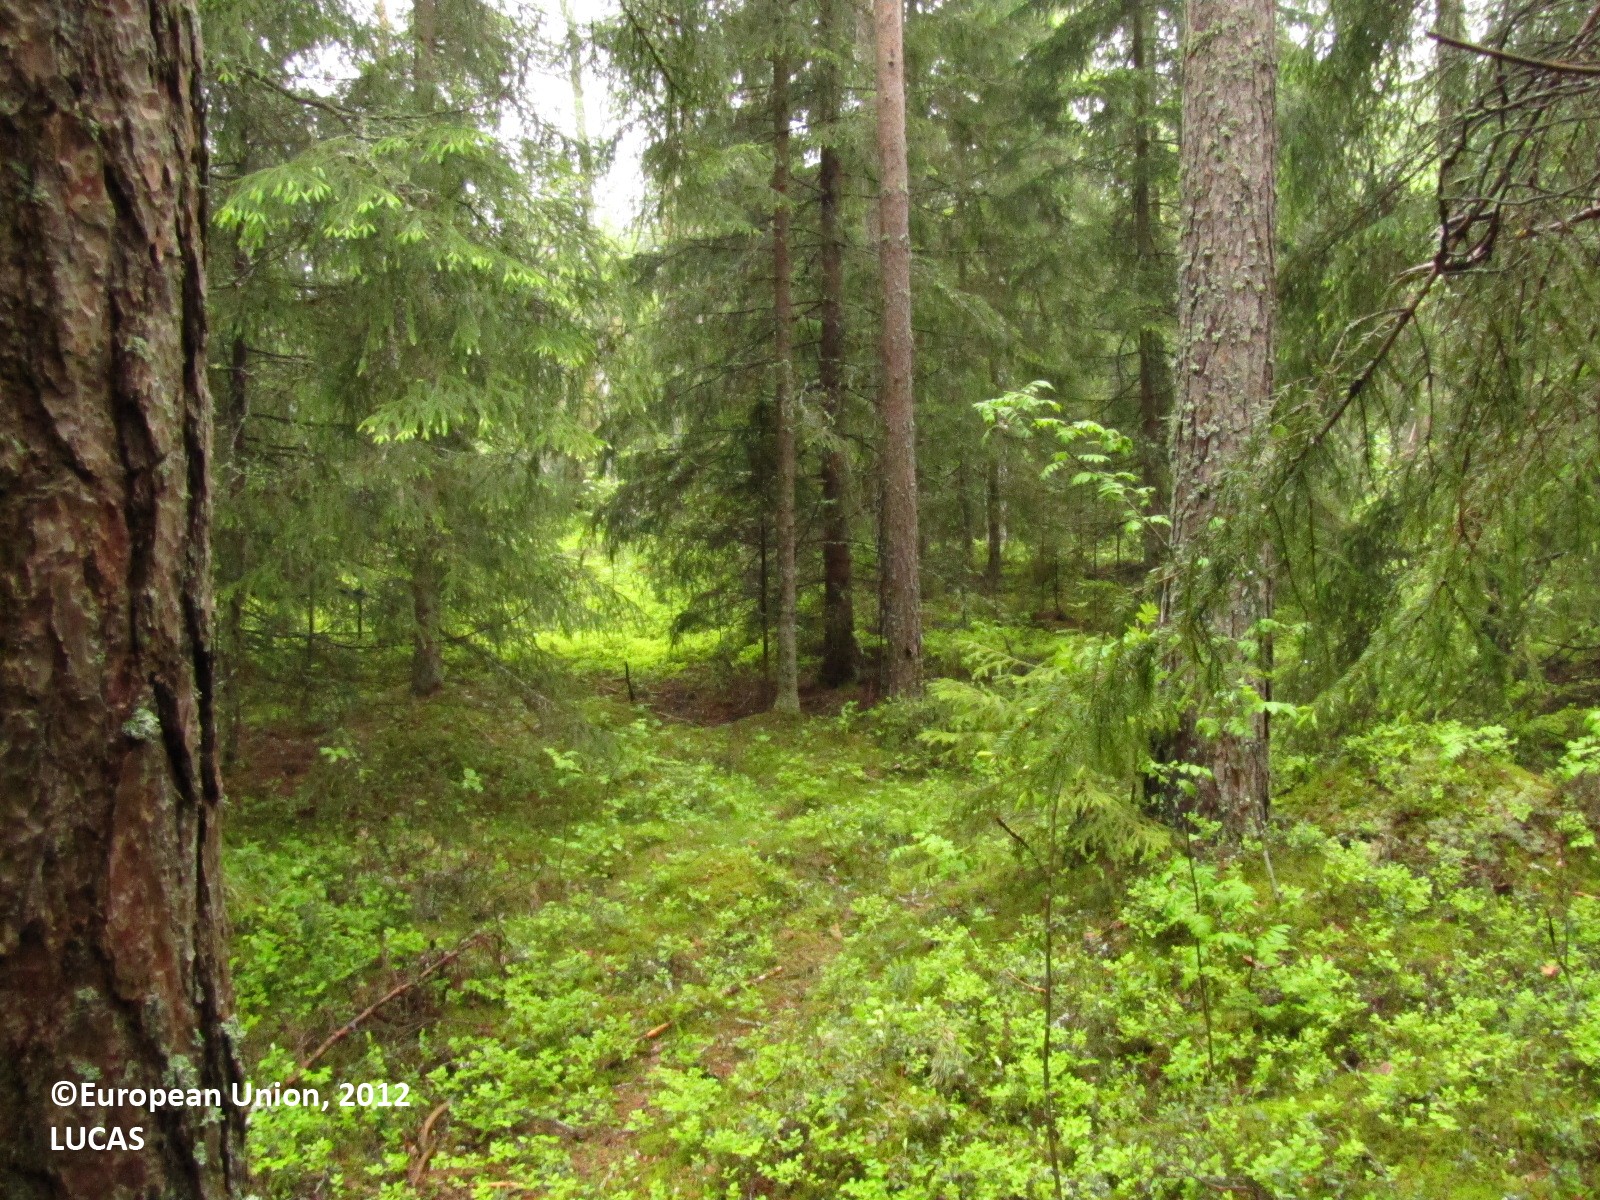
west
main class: Woodland
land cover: Spruce dominated coniferous woodland
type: hemiboreal forest and nemoral coniferous forest and mixed broadleaved-coniferous forest
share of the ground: > 75 %
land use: Forestry
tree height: > 5 m
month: June
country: FI
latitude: 61.4809
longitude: 22.9692
